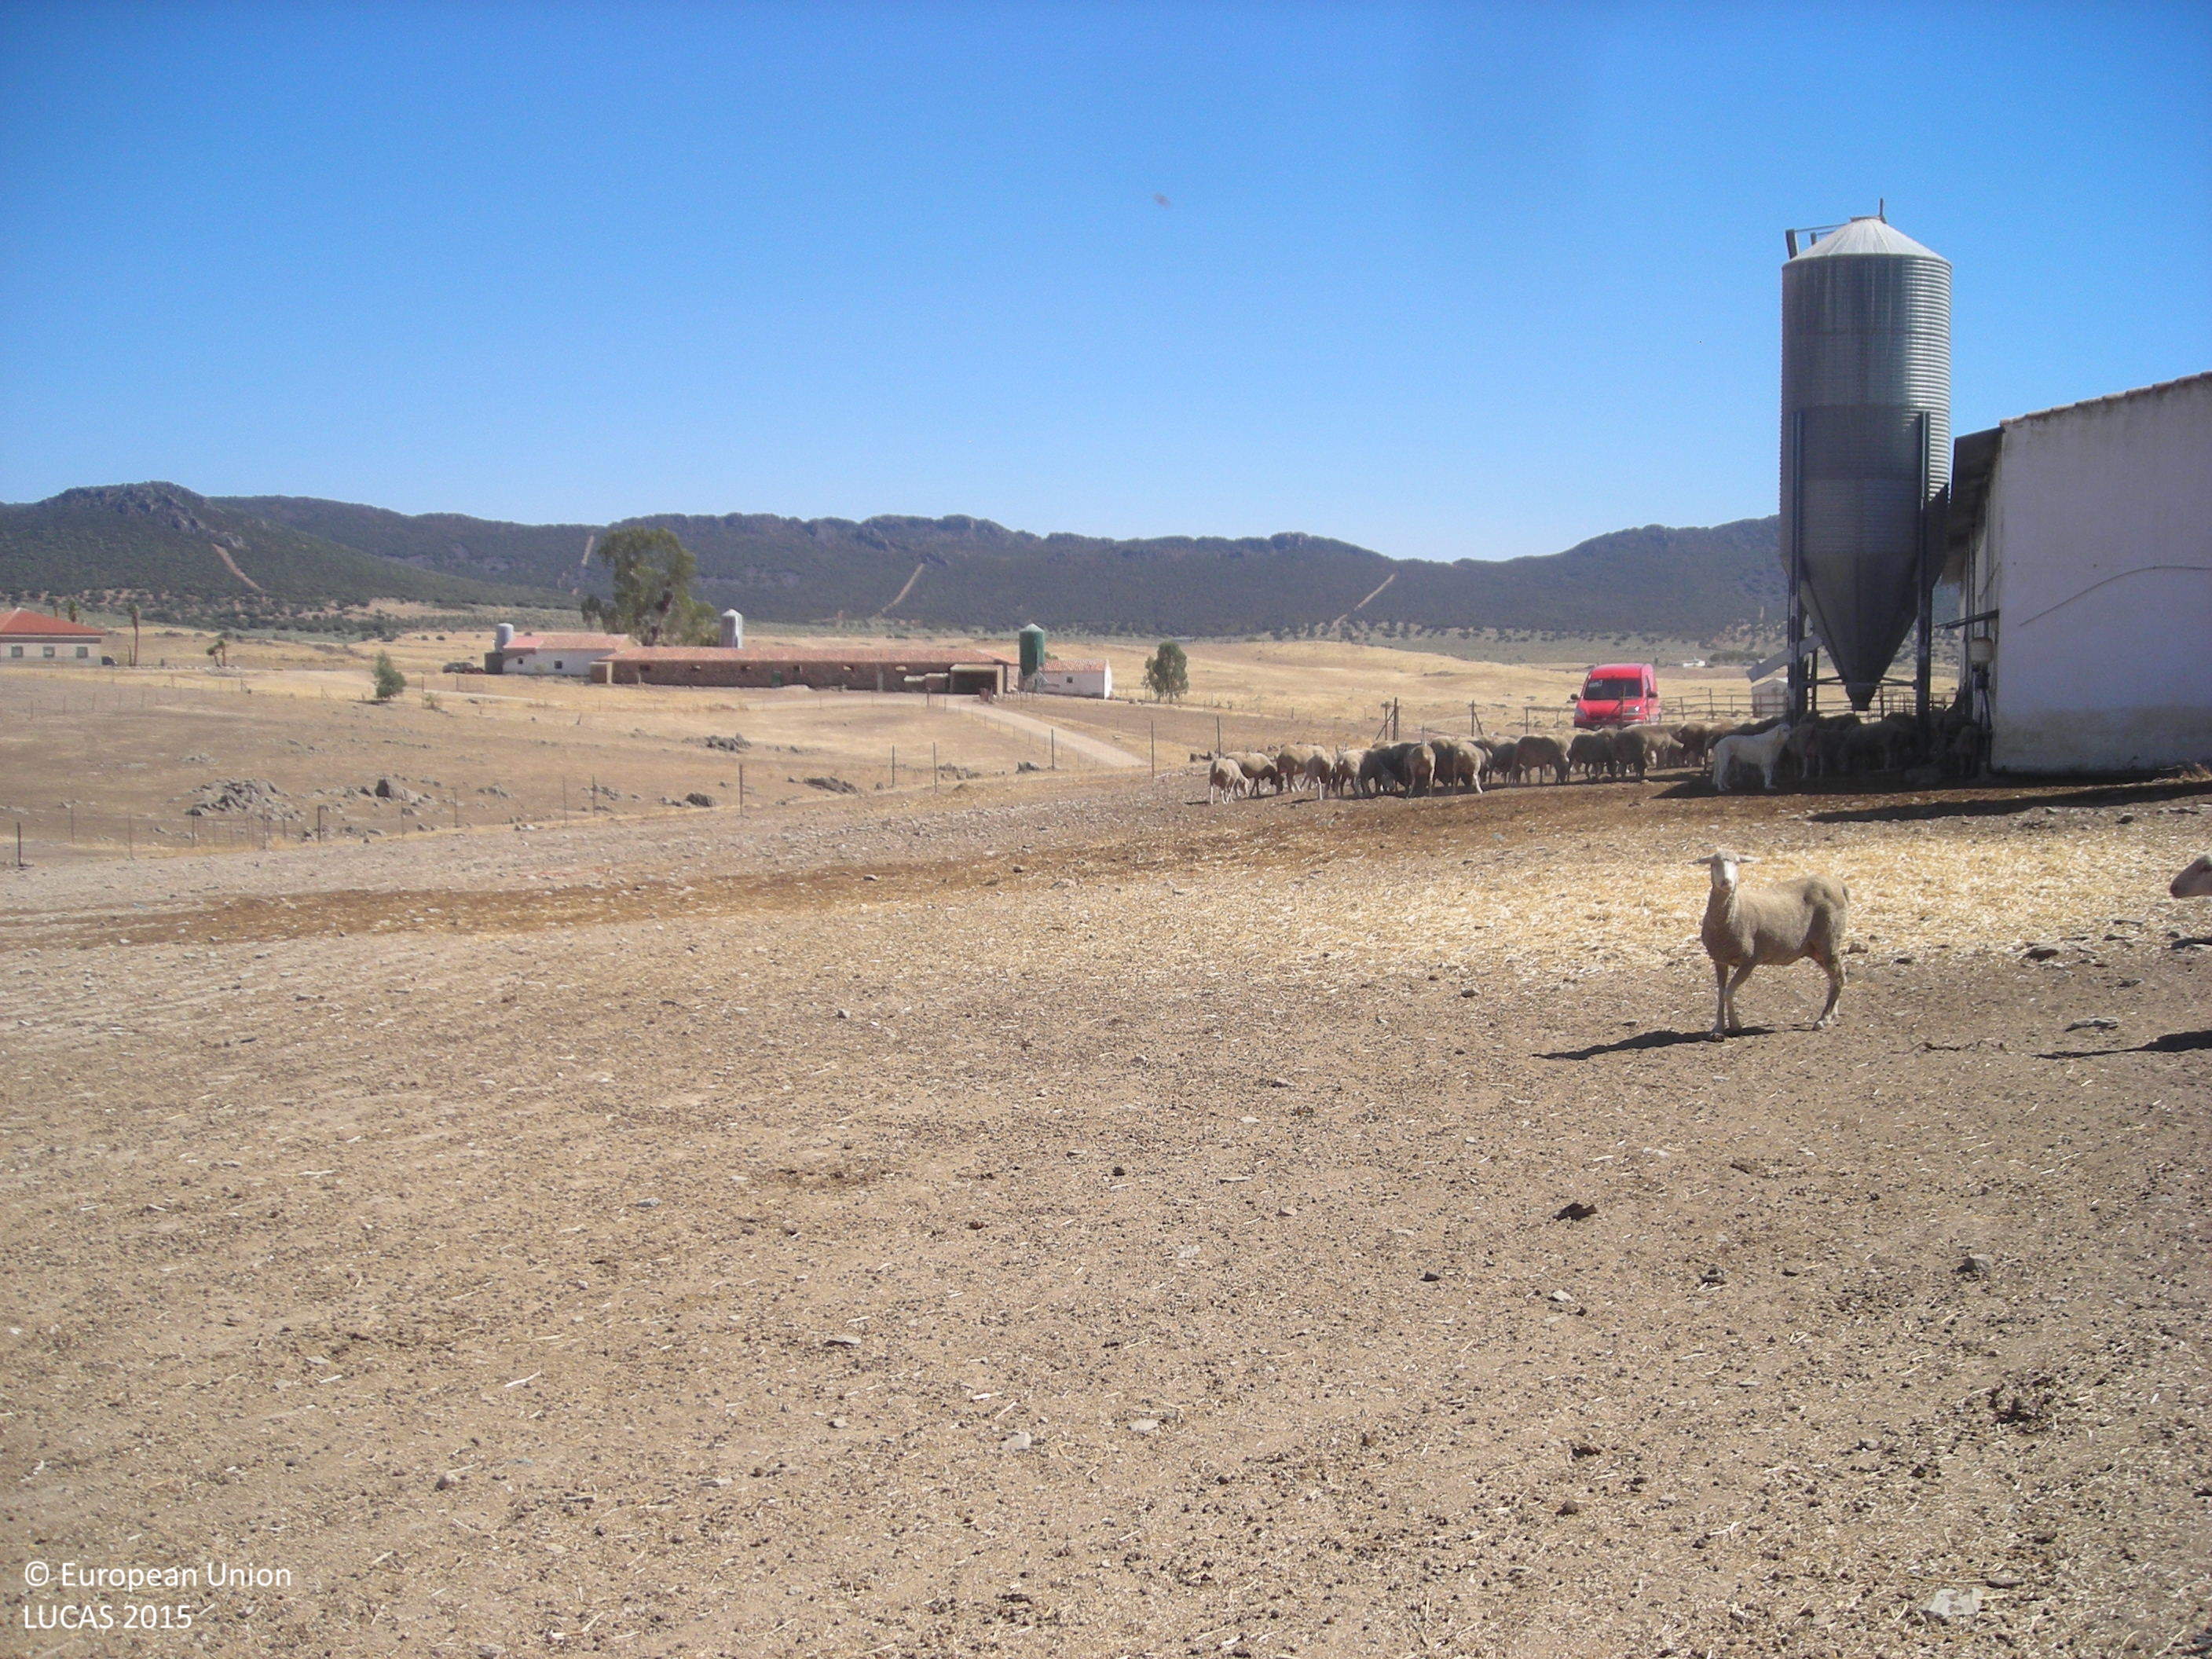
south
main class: Grassland
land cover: Grassland without tree/shrub cover
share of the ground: > 75 %
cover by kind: herbaceous plants 100 %
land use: Agriculture (excluding fallow land and kitchen gardens)
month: July
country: ES
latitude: 38.7315
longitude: -5.3945
